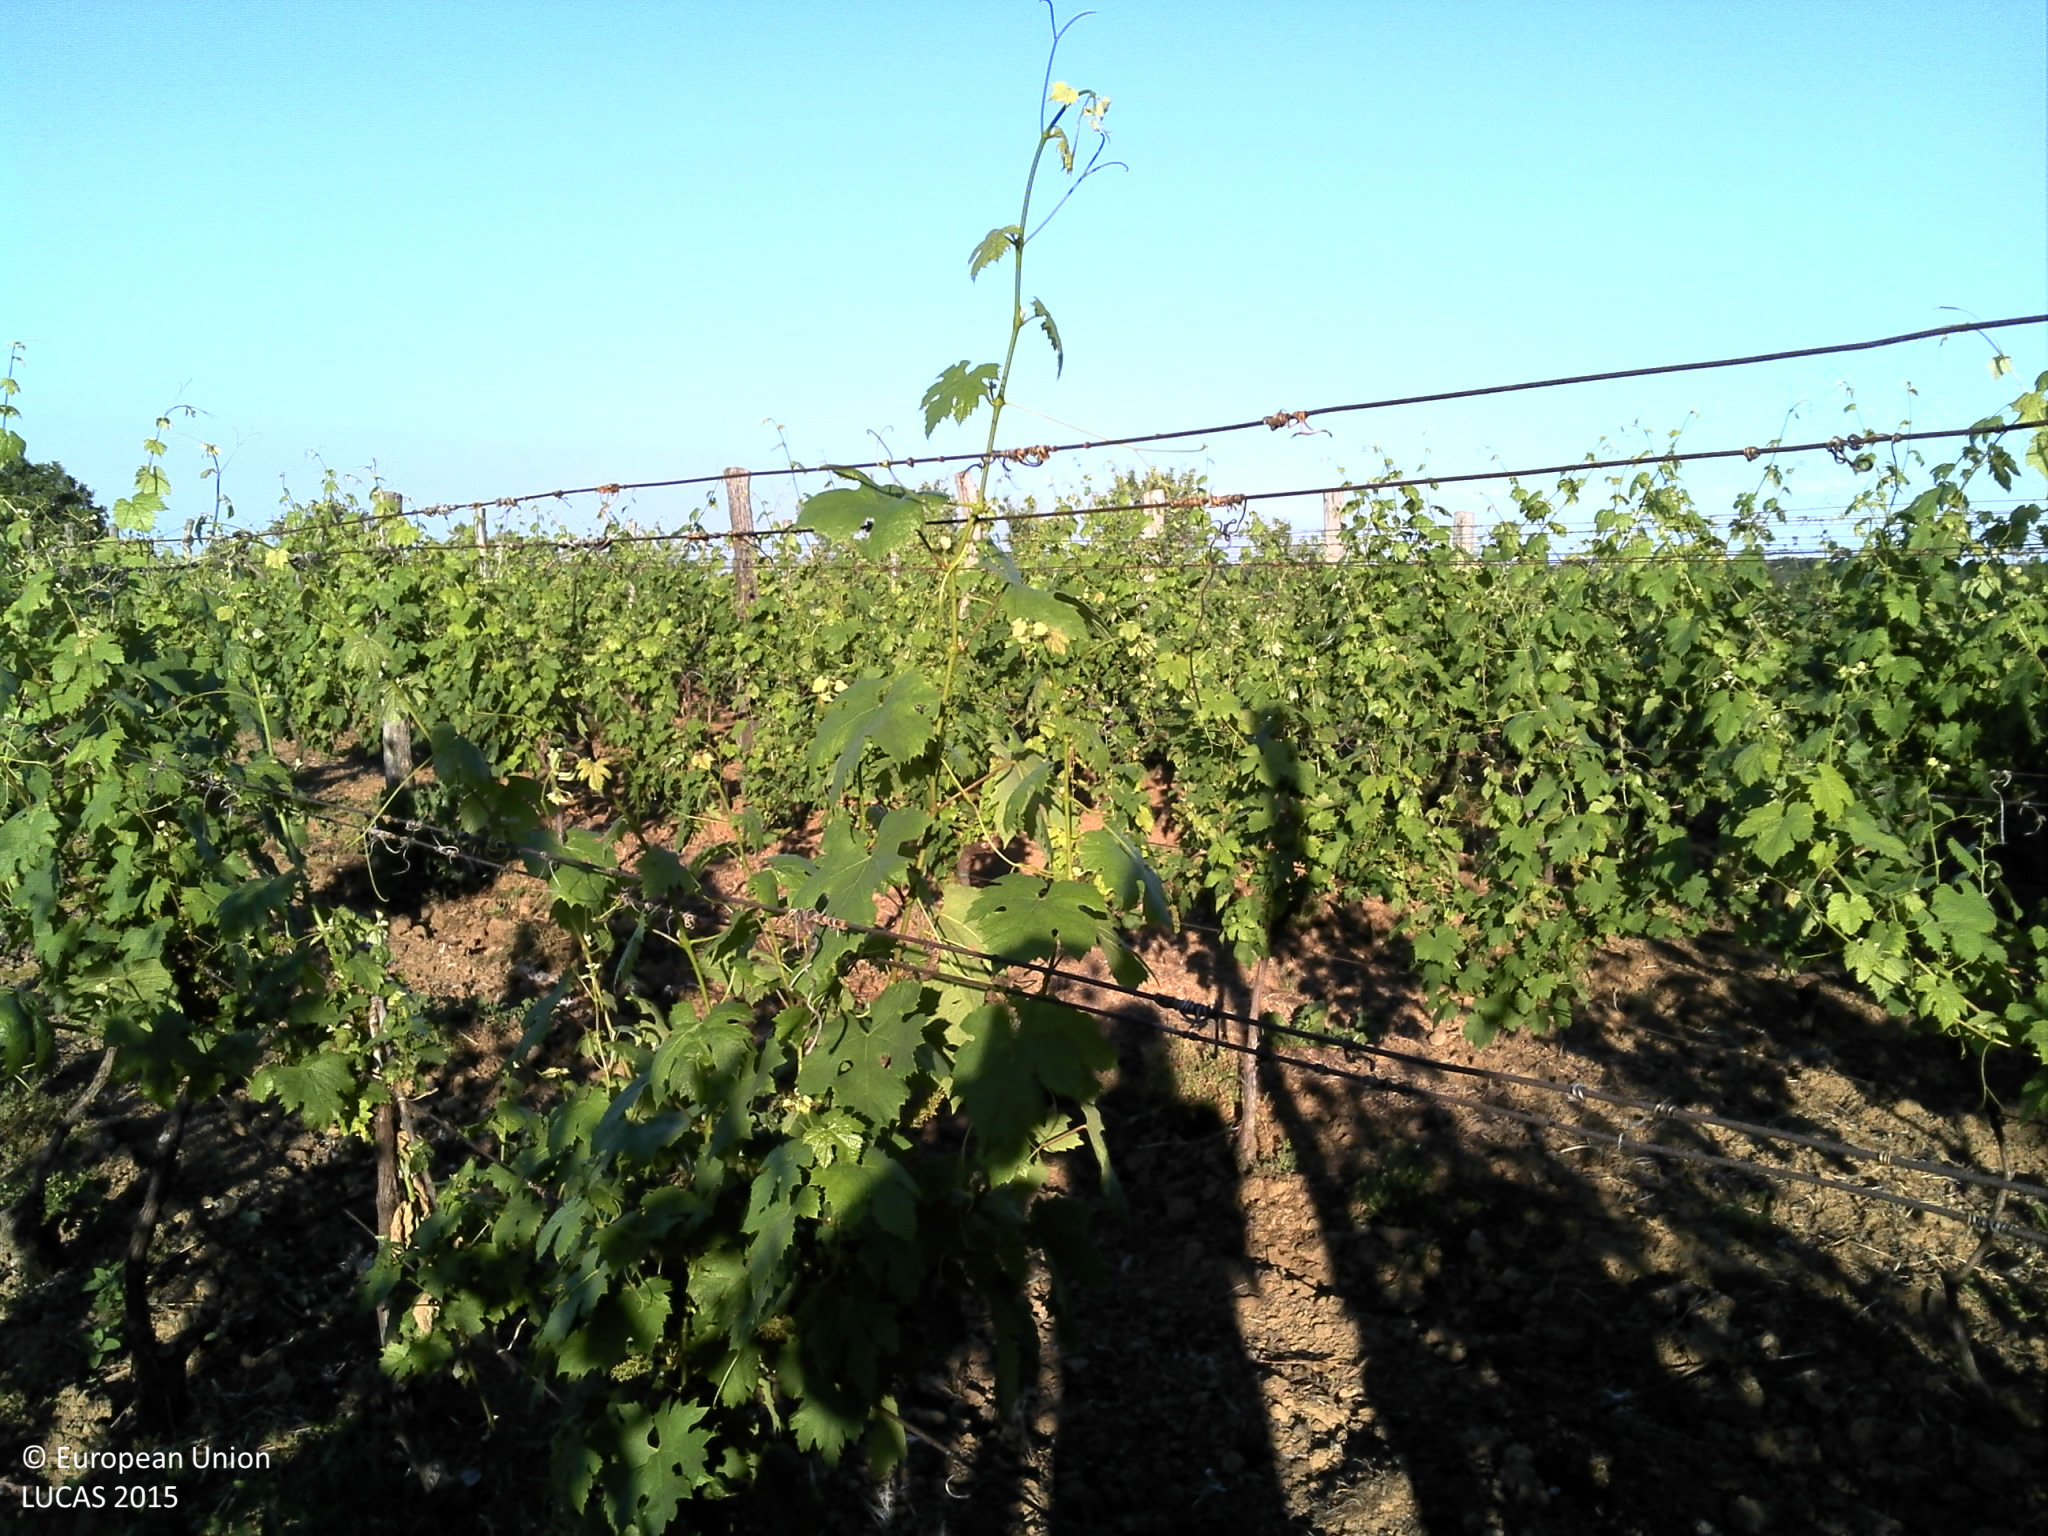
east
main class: Cropland
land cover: Vineyards
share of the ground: 10 - 25 %
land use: Agriculture (excluding fallow land and kitchen gardens)
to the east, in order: Vineyards; Tracks; Common wheat; Other fruit trees and berries; Common wheat; Maize
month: June
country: HR
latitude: 45.2093
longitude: 19.4201
